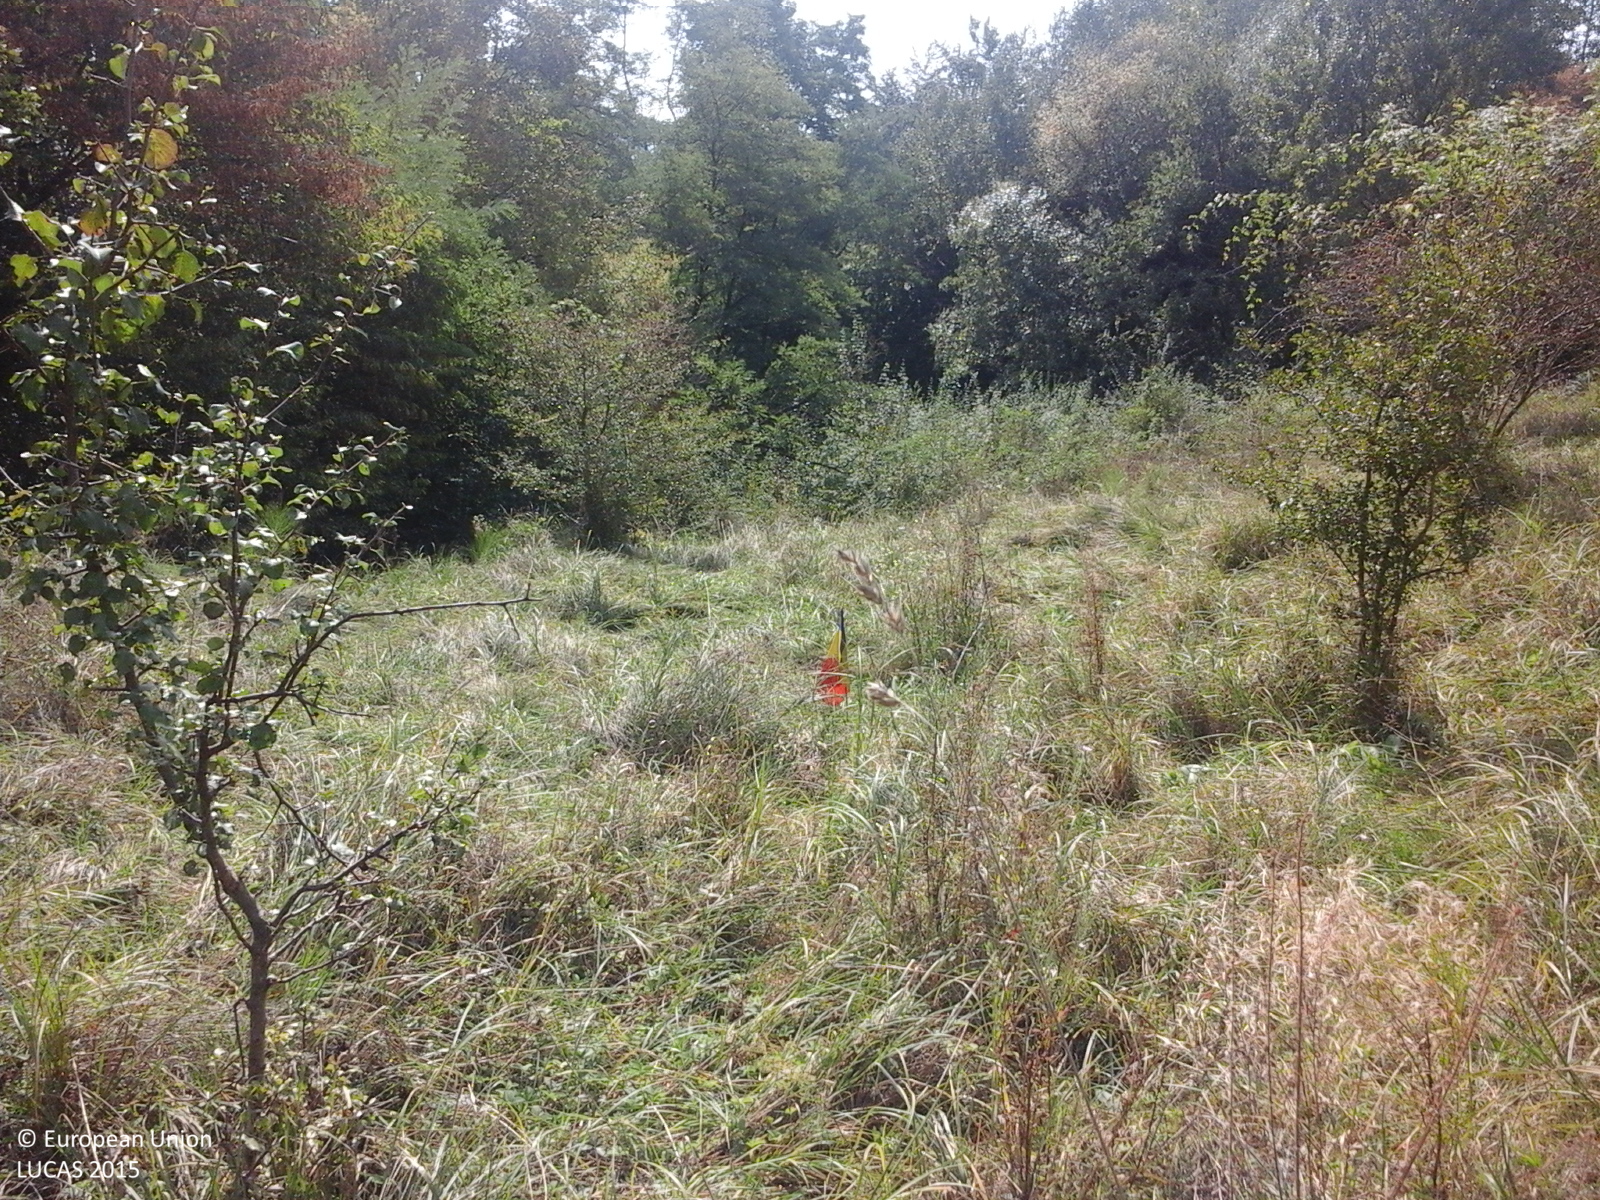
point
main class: Grassland
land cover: Grassland with sparse tree/shrub cover
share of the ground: > 75 %
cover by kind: herbaceous plants 95 %, broadleaved forest trees 5 %
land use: Fallow land
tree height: < 5 m
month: September
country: RO
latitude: 47.2471
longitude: 23.7514
